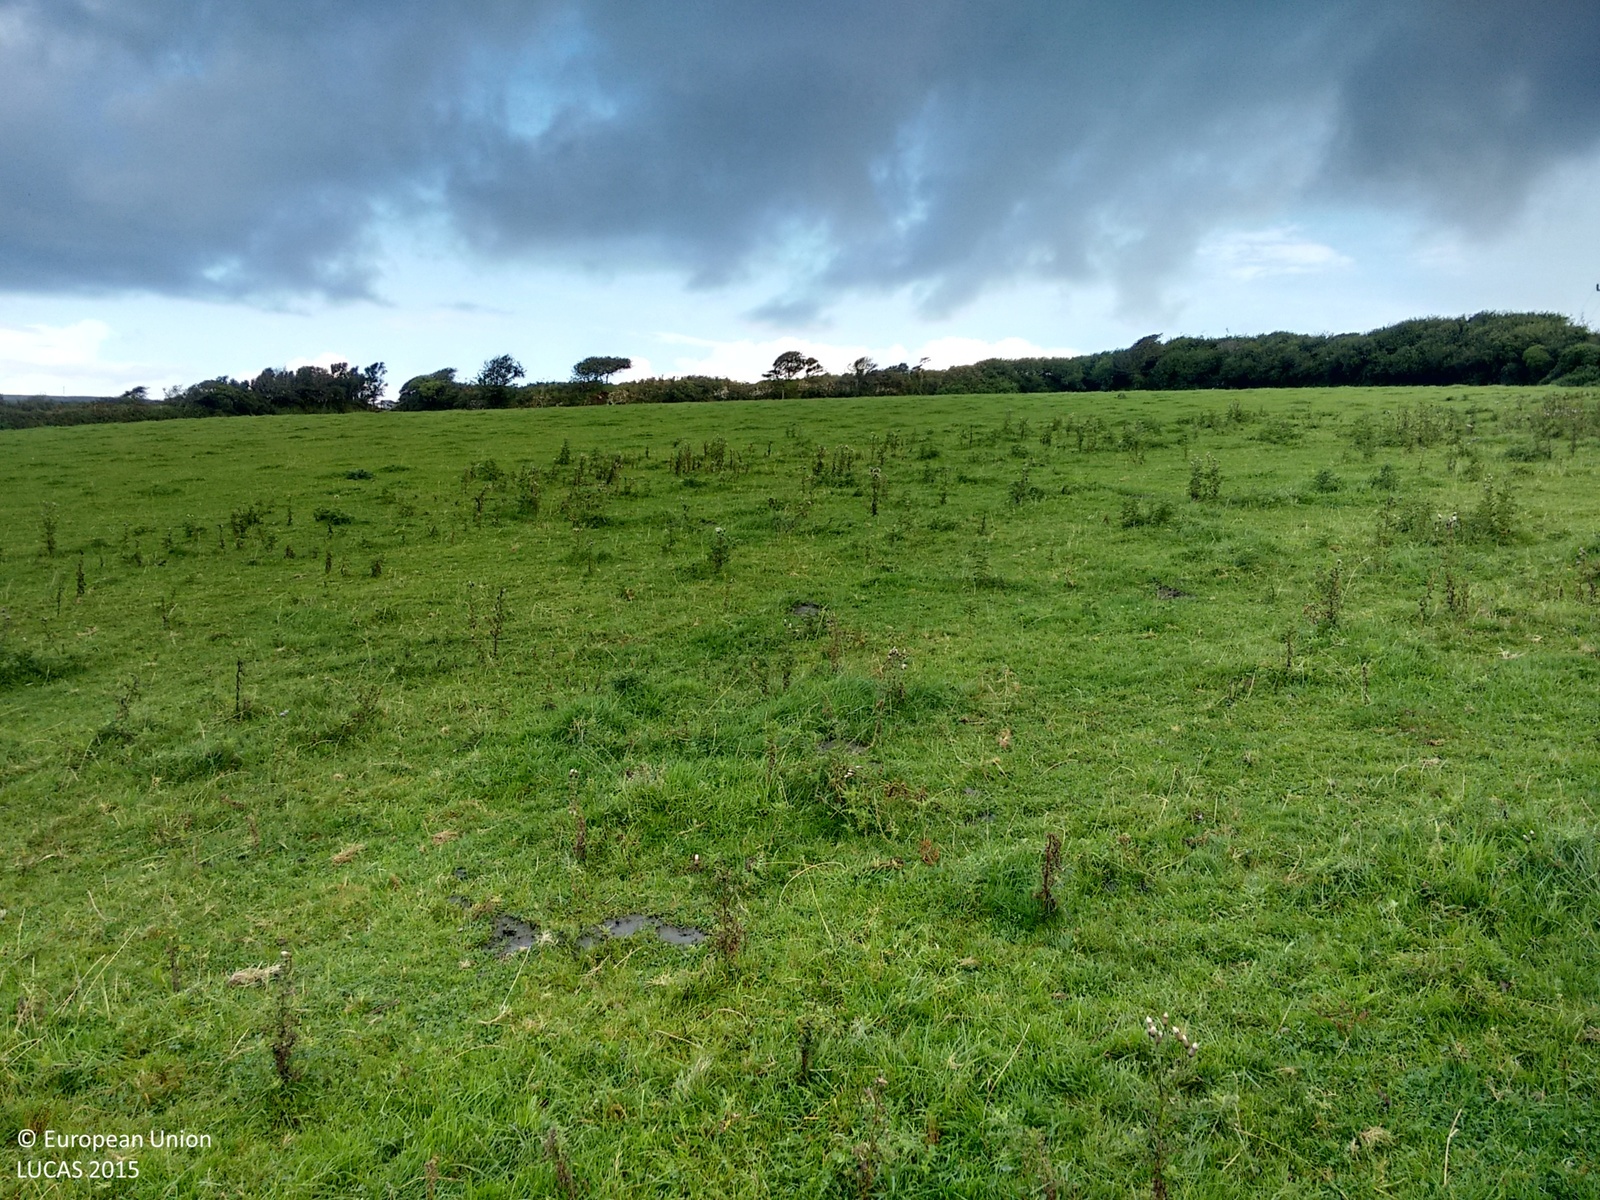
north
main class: Grassland
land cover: Grassland without tree/shrub cover
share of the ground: > 75 %
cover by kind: herbaceous plants 100 %
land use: Agriculture (excluding fallow land and kitchen gardens)
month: August
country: GB
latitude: 50.1757
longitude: -5.5167
